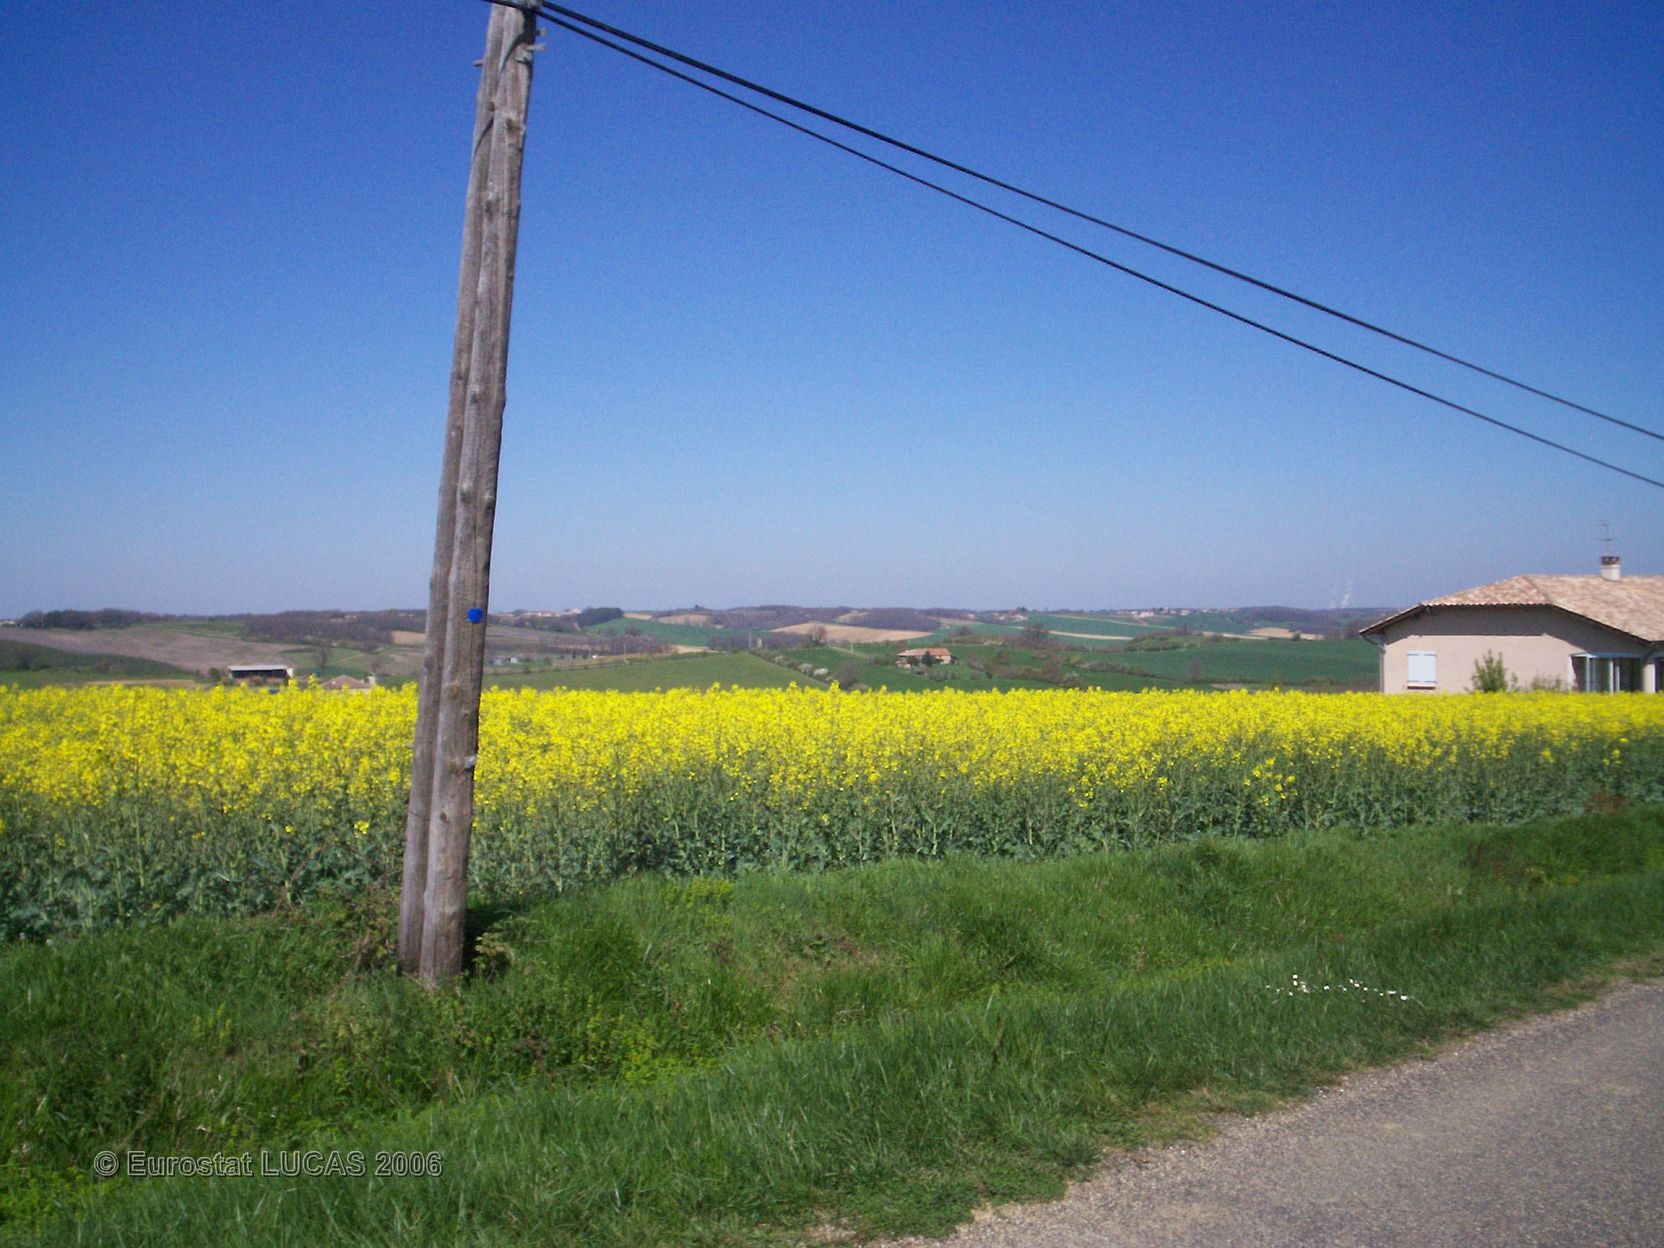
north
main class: Grassland
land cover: Grassland without tree/shrub cover
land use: Agriculture (excluding fallow land and kitchen gardens)
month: April
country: FR
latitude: 43.9334
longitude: 0.9169
